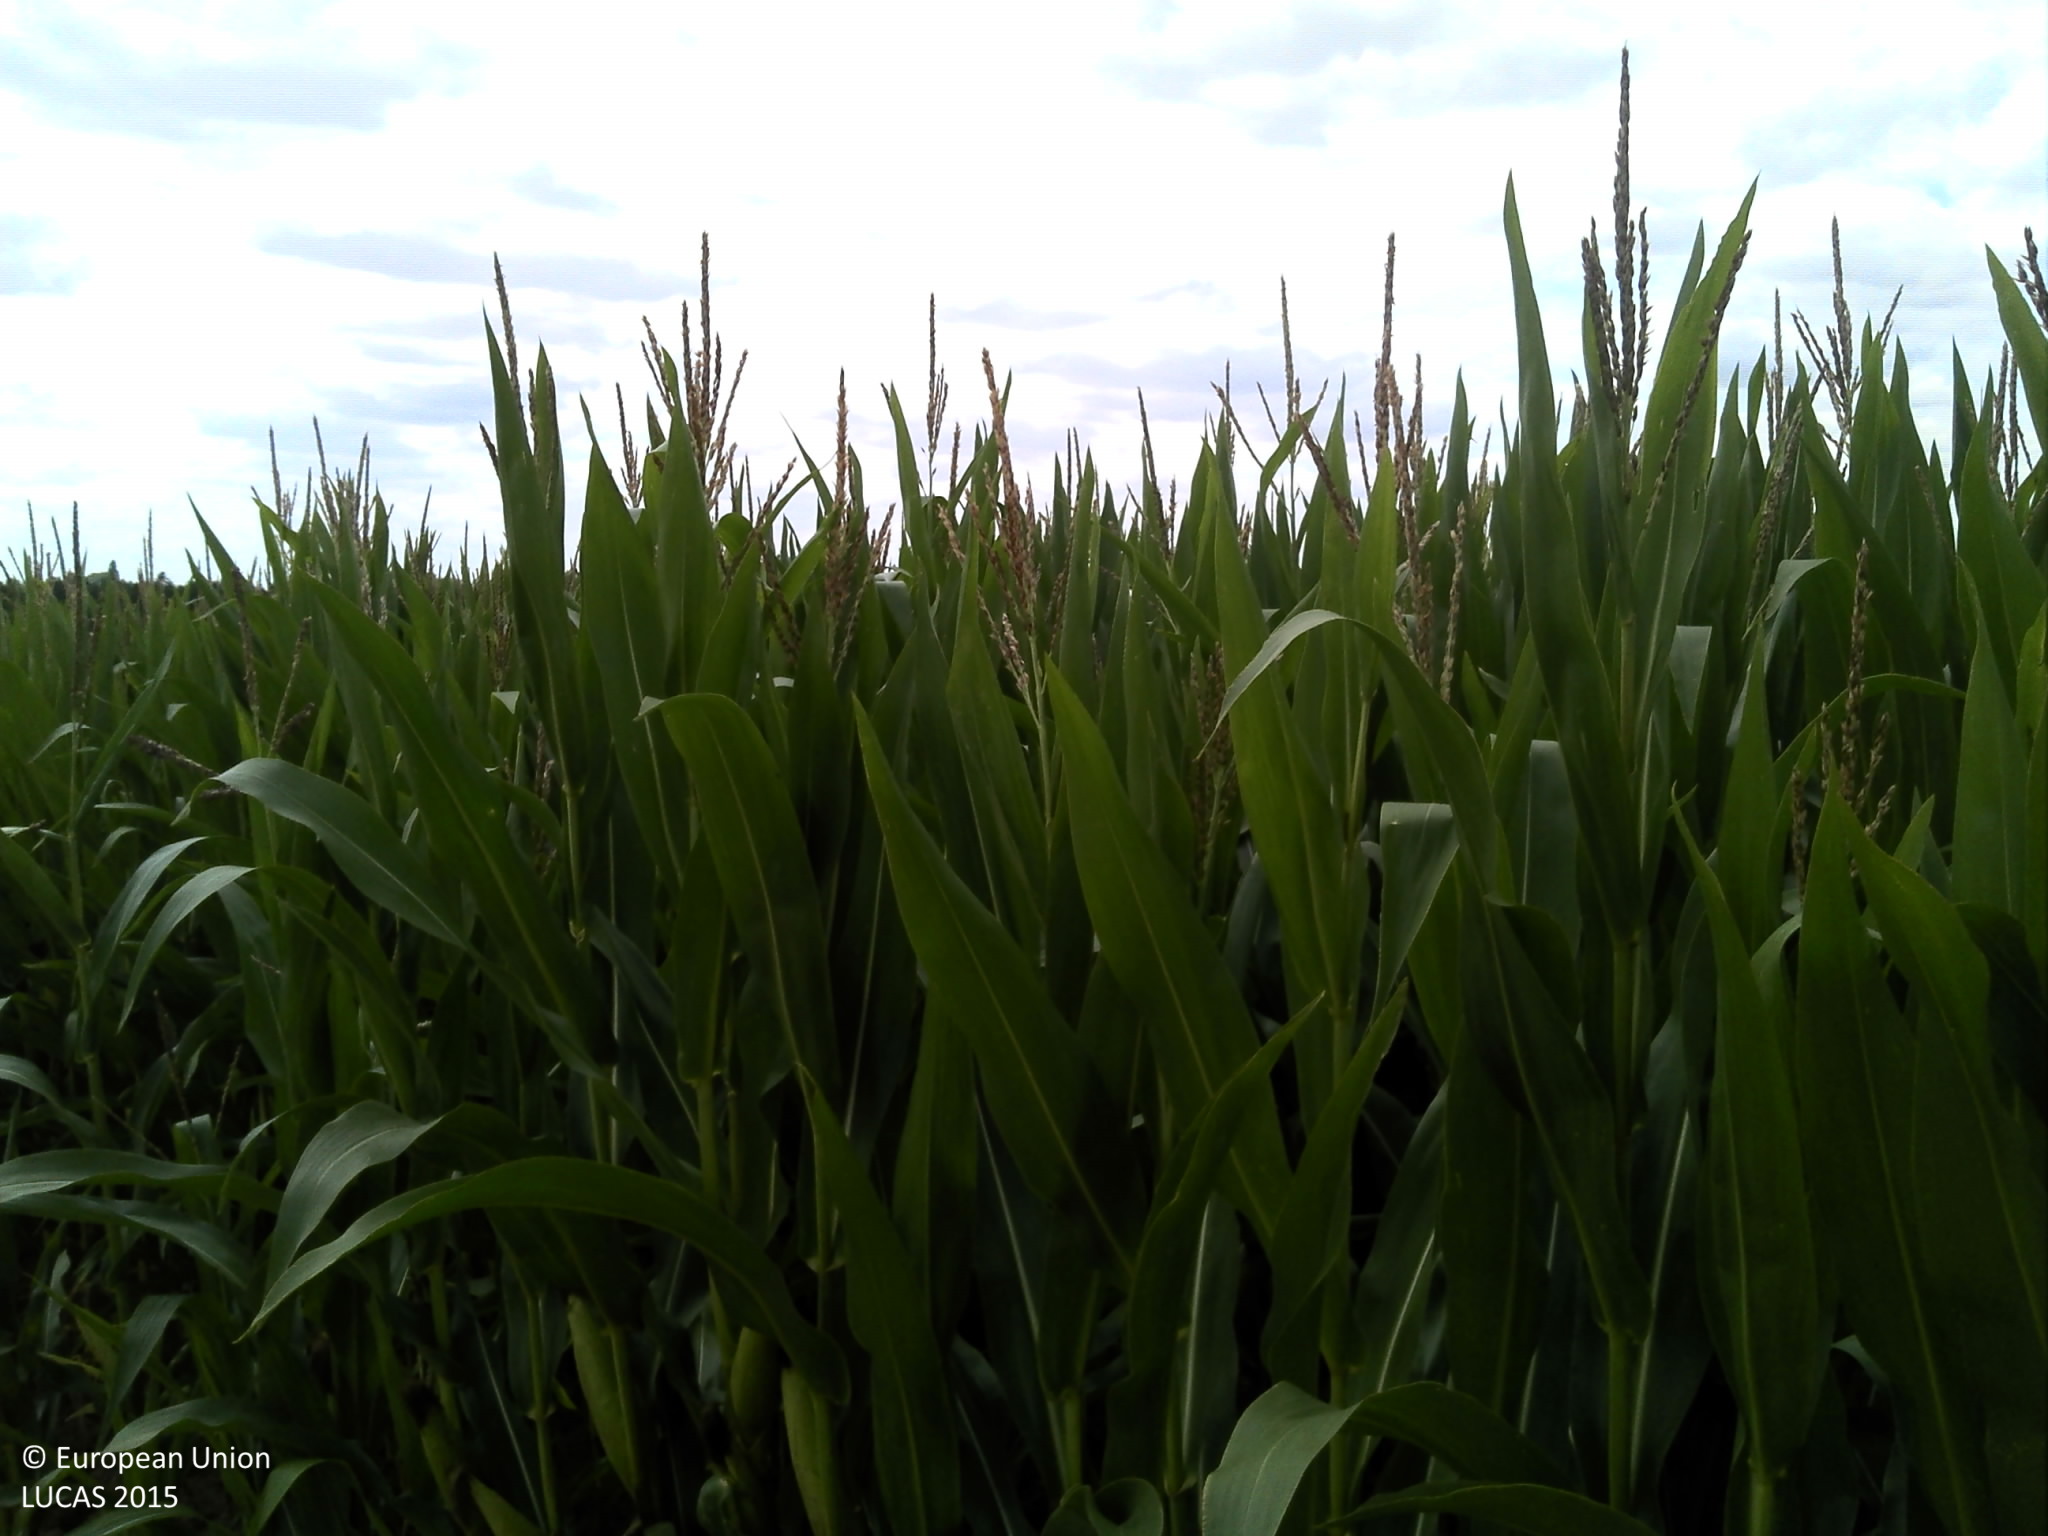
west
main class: Cropland
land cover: Maize
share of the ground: > 75 %
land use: Agriculture (excluding fallow land and kitchen gardens)
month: July
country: FR
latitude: 49.5831
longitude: 4.5051
